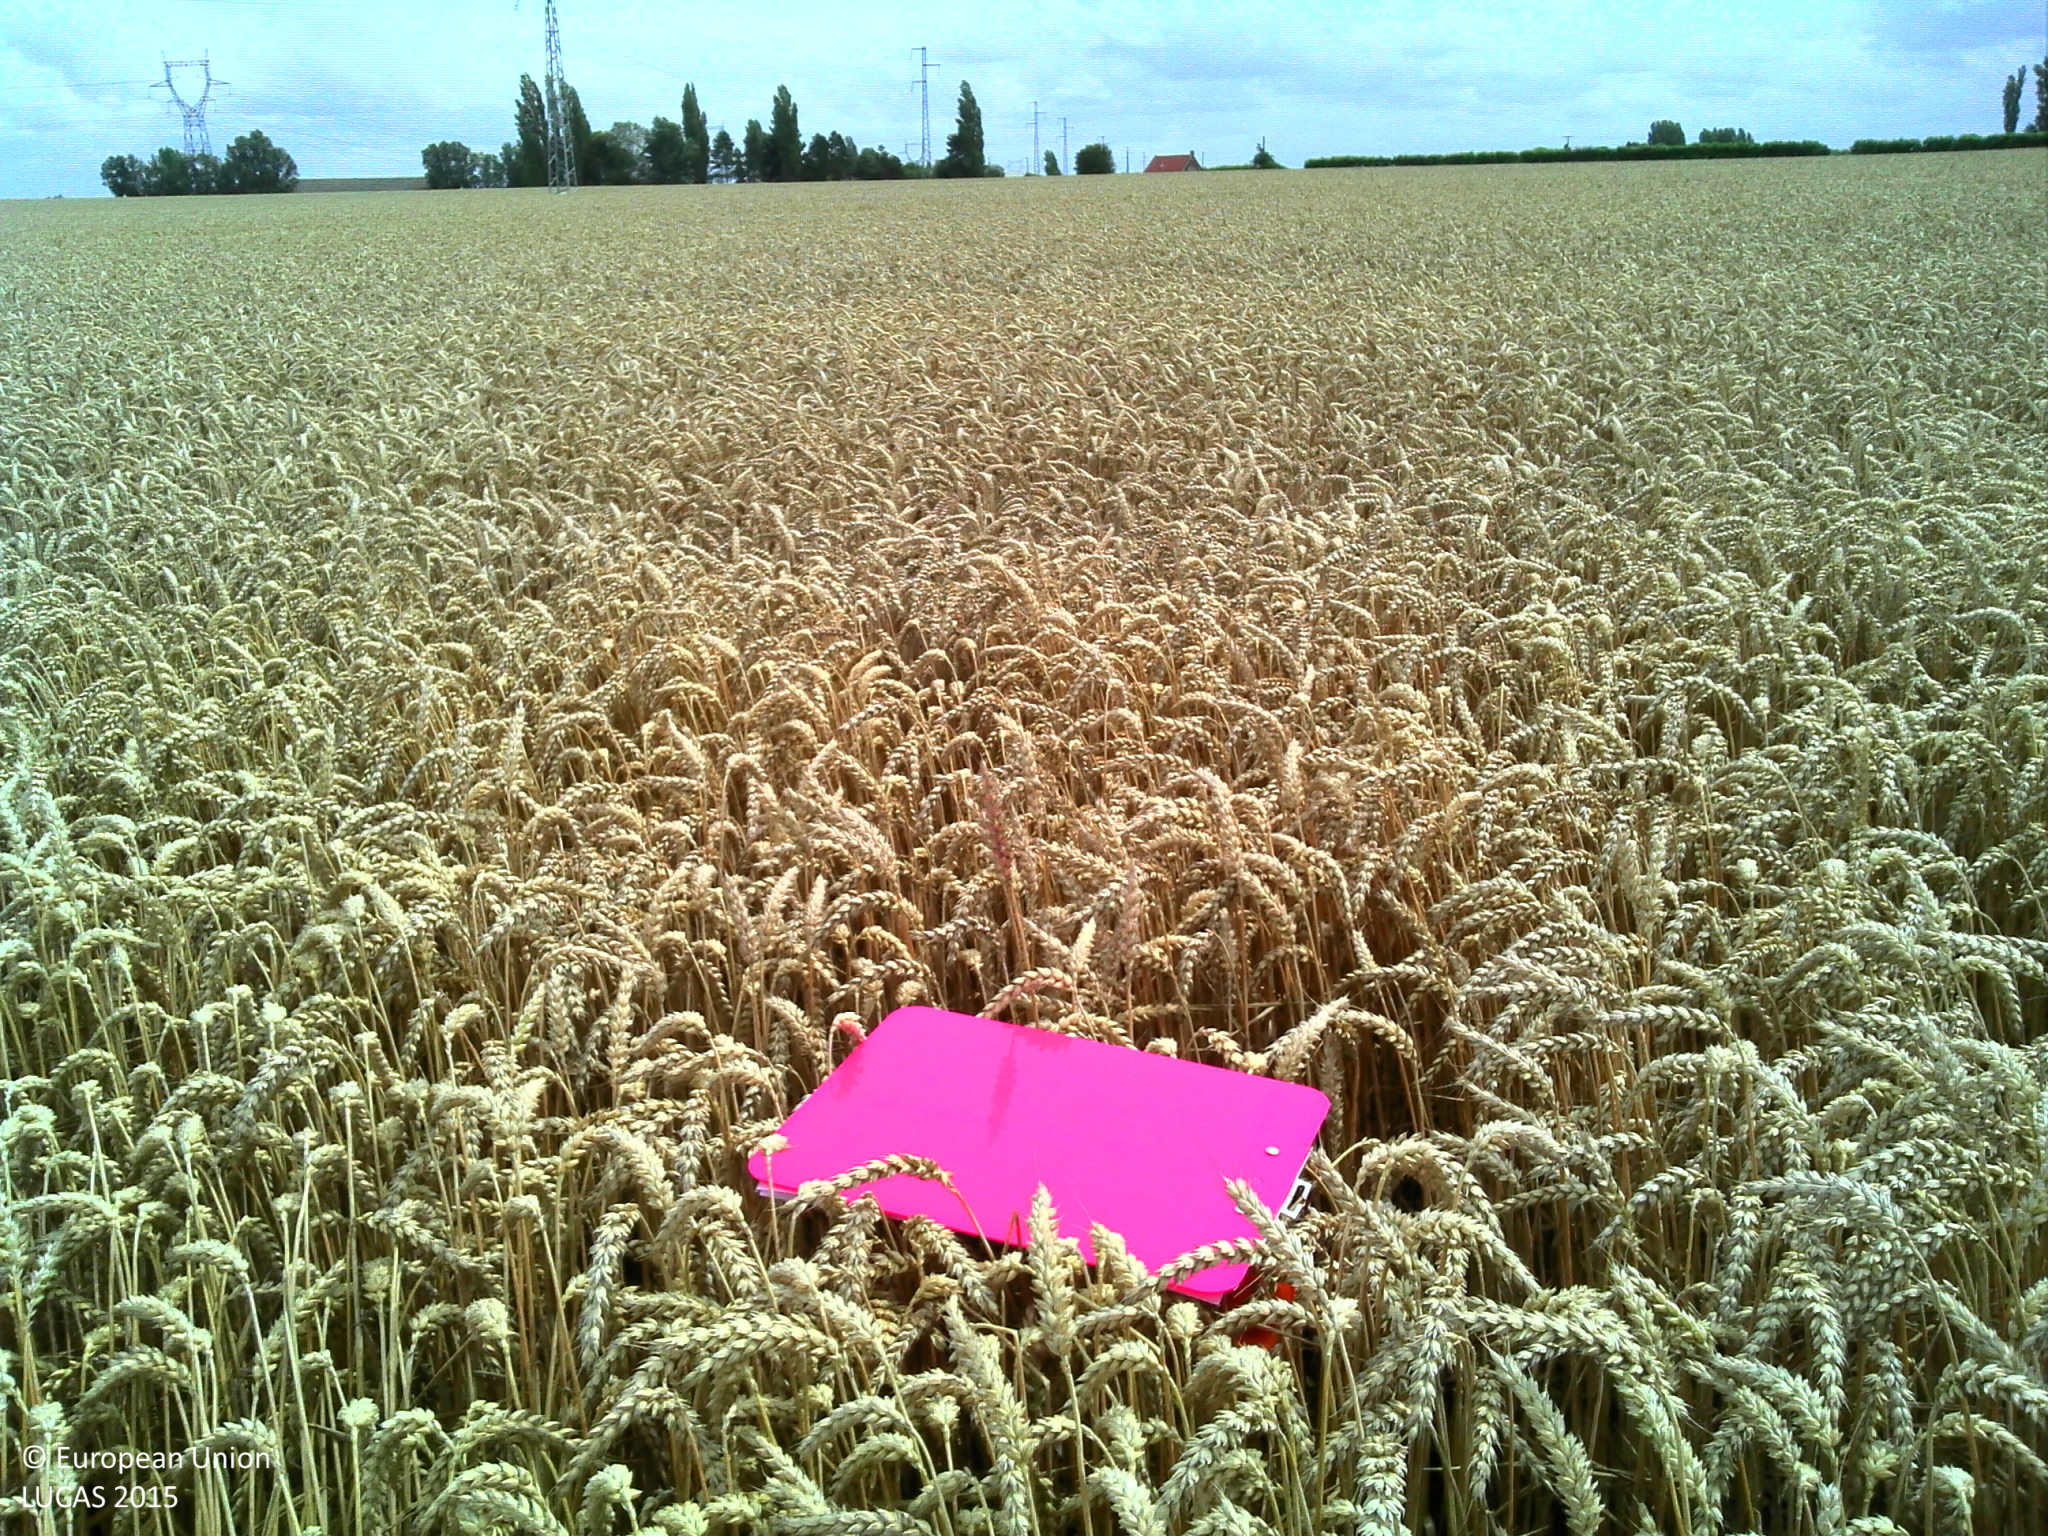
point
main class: Cropland
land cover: Common wheat
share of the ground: > 75 %
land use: Agriculture (excluding fallow land and kitchen gardens)
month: July
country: FR
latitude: 50.7632
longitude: 2.4302
